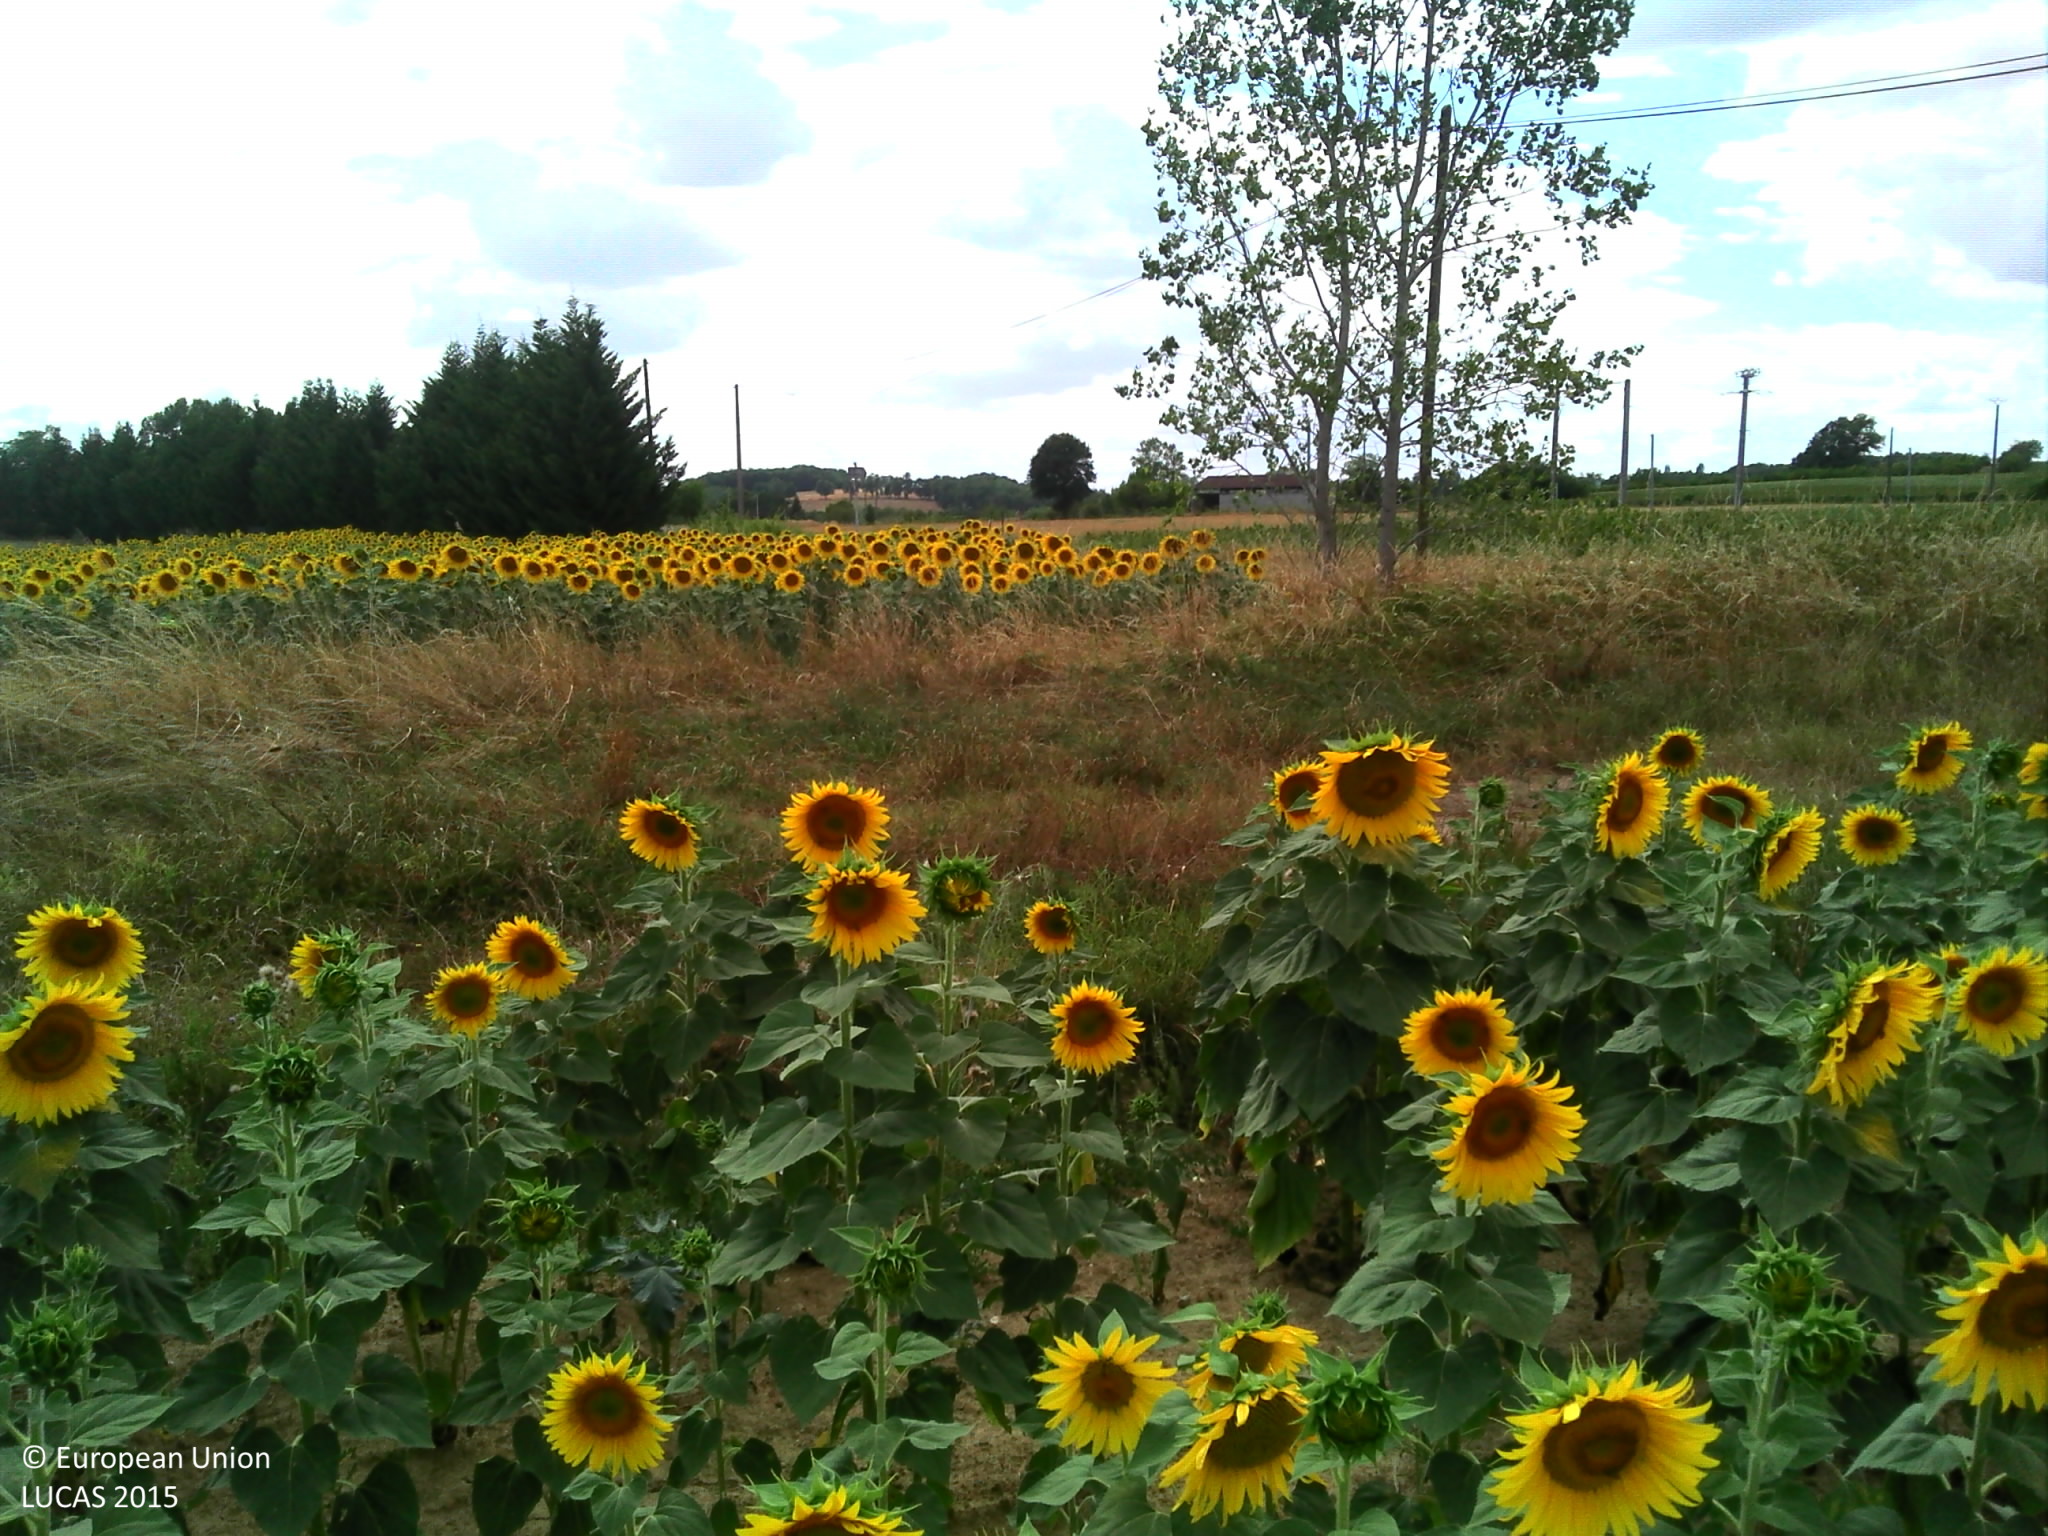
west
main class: Cropland
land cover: Sunflower
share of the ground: 50 - 75 %
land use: Agriculture (excluding fallow land and kitchen gardens)
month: July
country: FR
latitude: 44.4543
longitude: 0.6561
